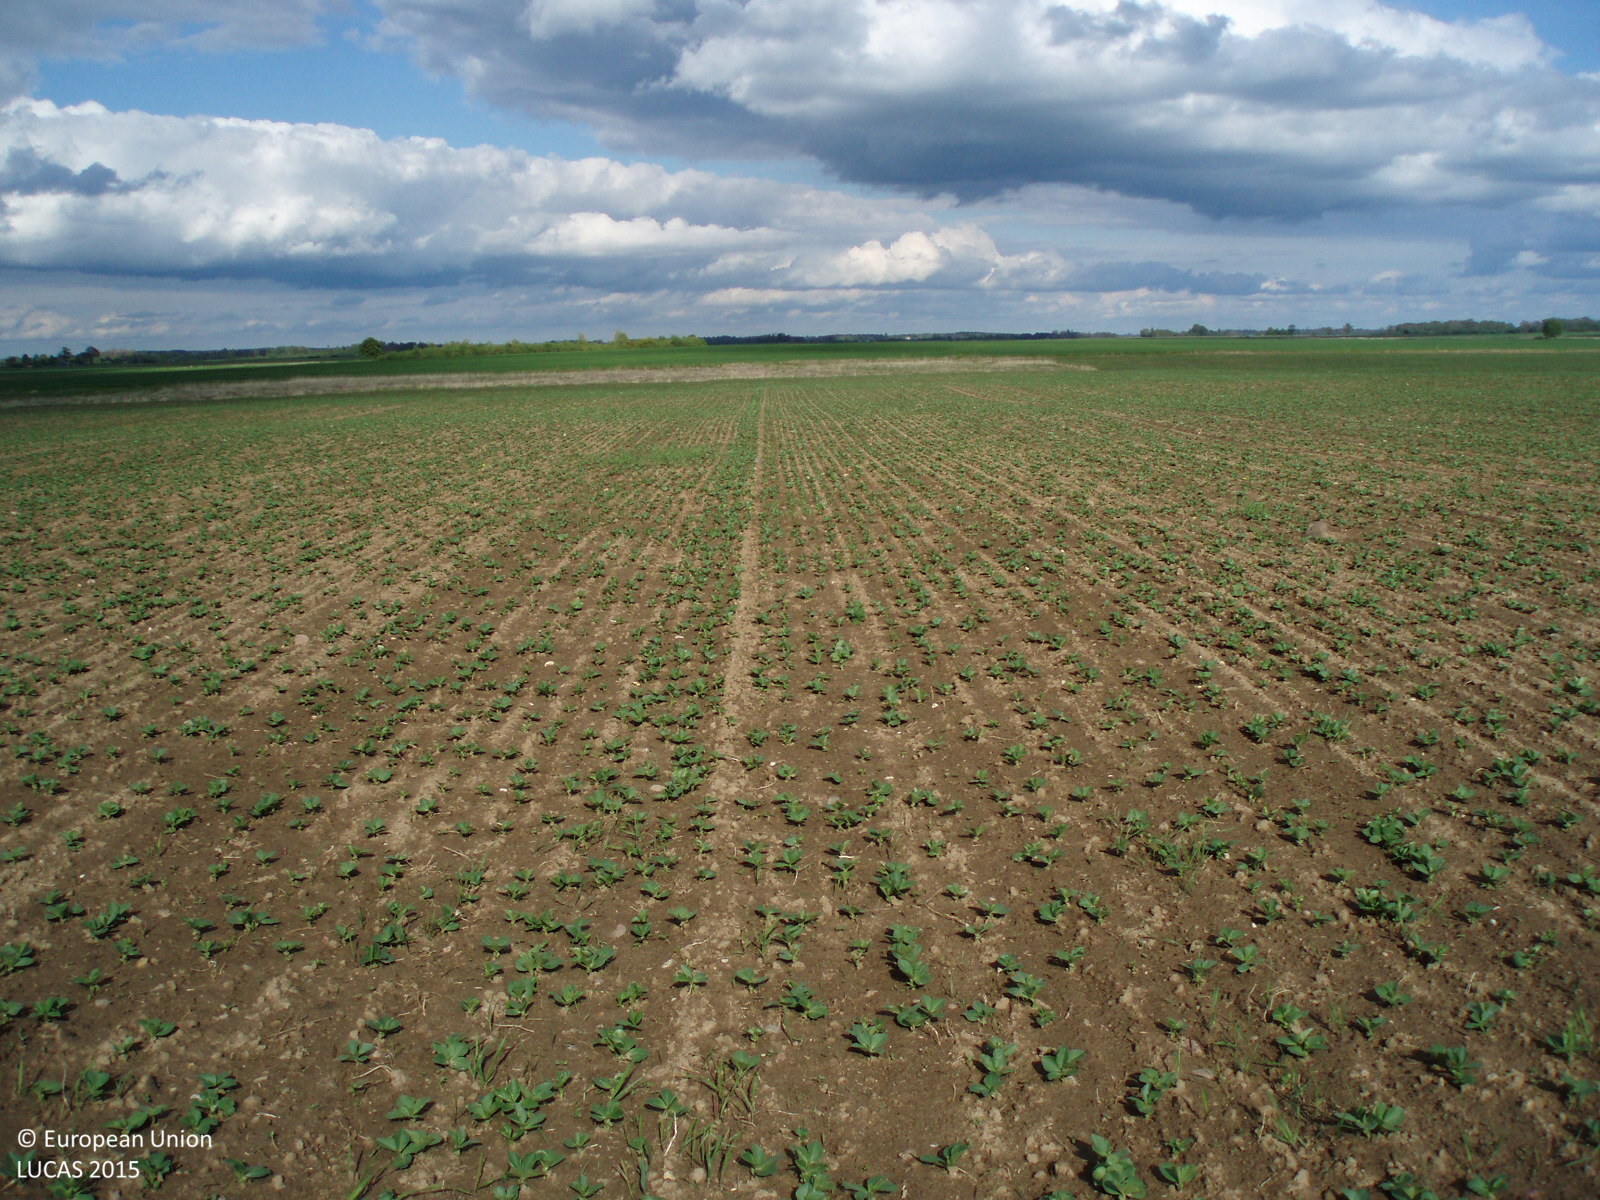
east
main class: Cropland
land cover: Dry pulses
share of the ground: 25 - 50 %
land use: Agriculture (excluding fallow land and kitchen gardens)
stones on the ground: < 10 %
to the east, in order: Dry pulses; Spontaneously vegetated surfaces; Grass margins; Paved roads, cycling and walking lanes; Barley
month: May
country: LT
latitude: 56.3680
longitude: 22.5732
